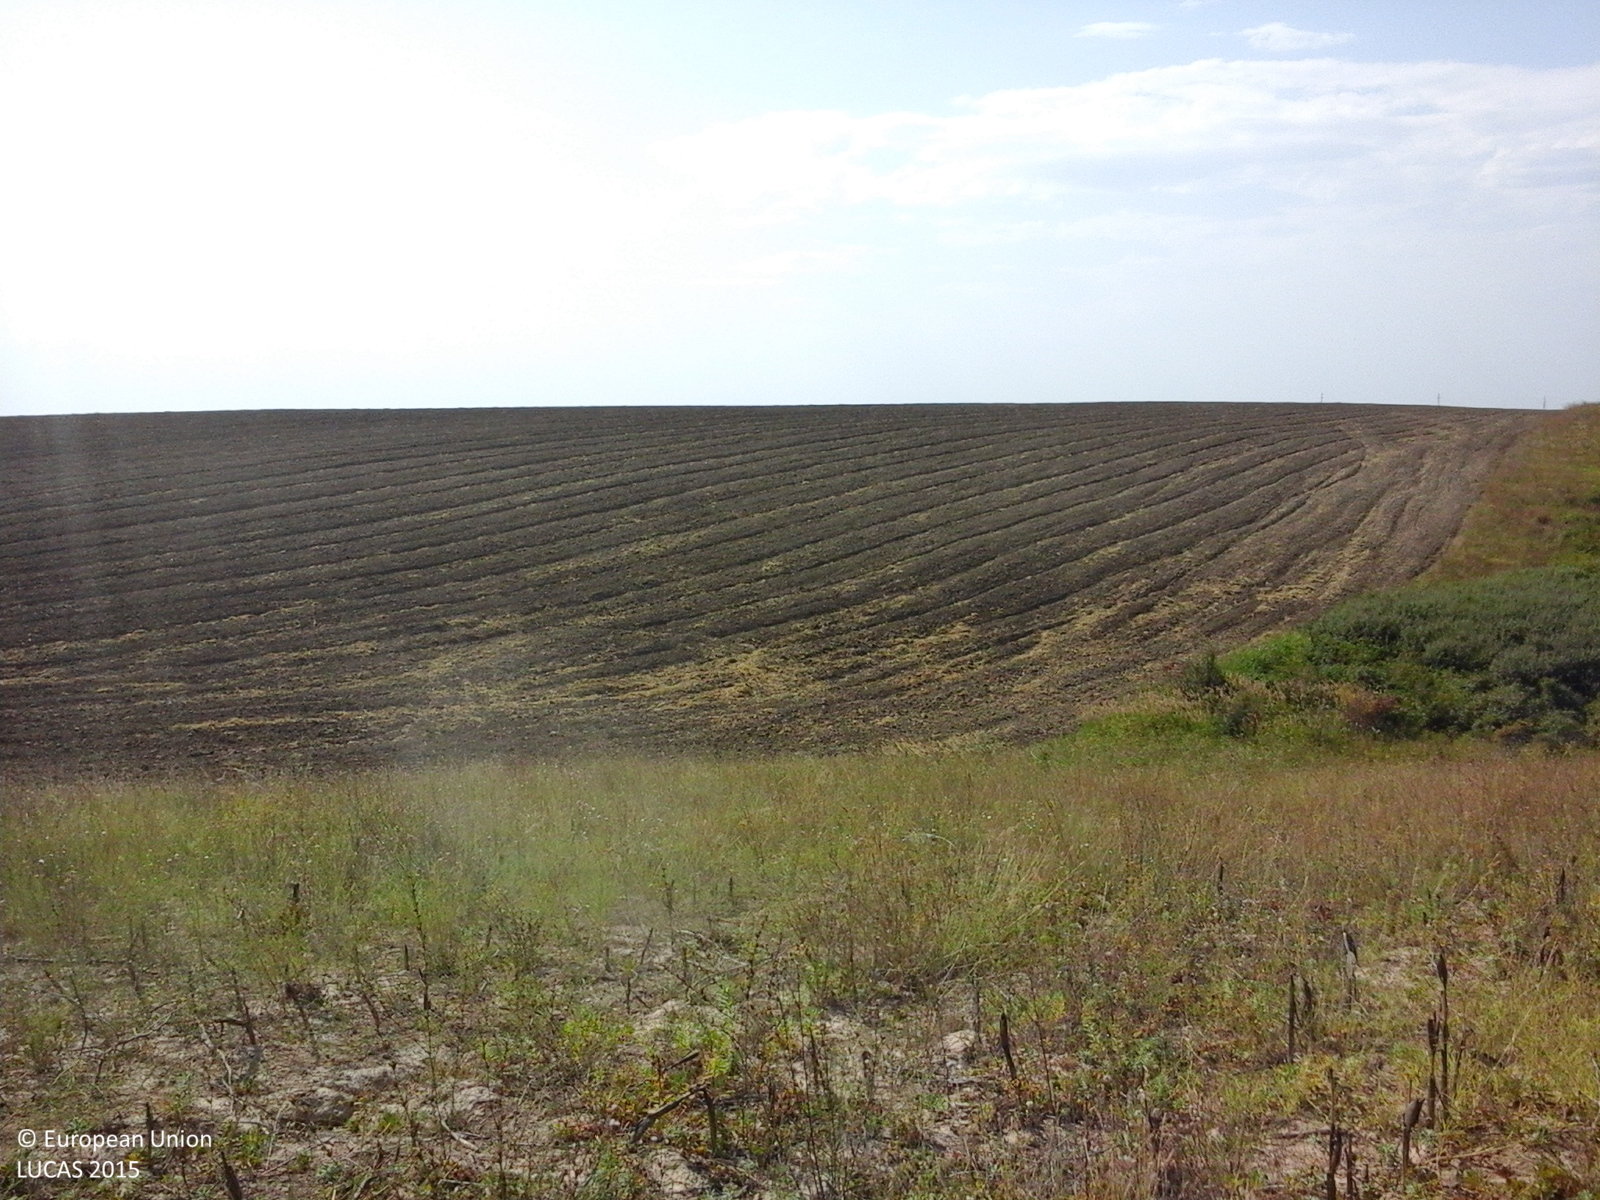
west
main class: Grassland
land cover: Spontaneously vegetated surfaces
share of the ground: 10 - 25 %
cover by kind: herbaceous plants 100 %
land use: Fallow land
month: August
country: RO
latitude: 44.1886
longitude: 27.9554
